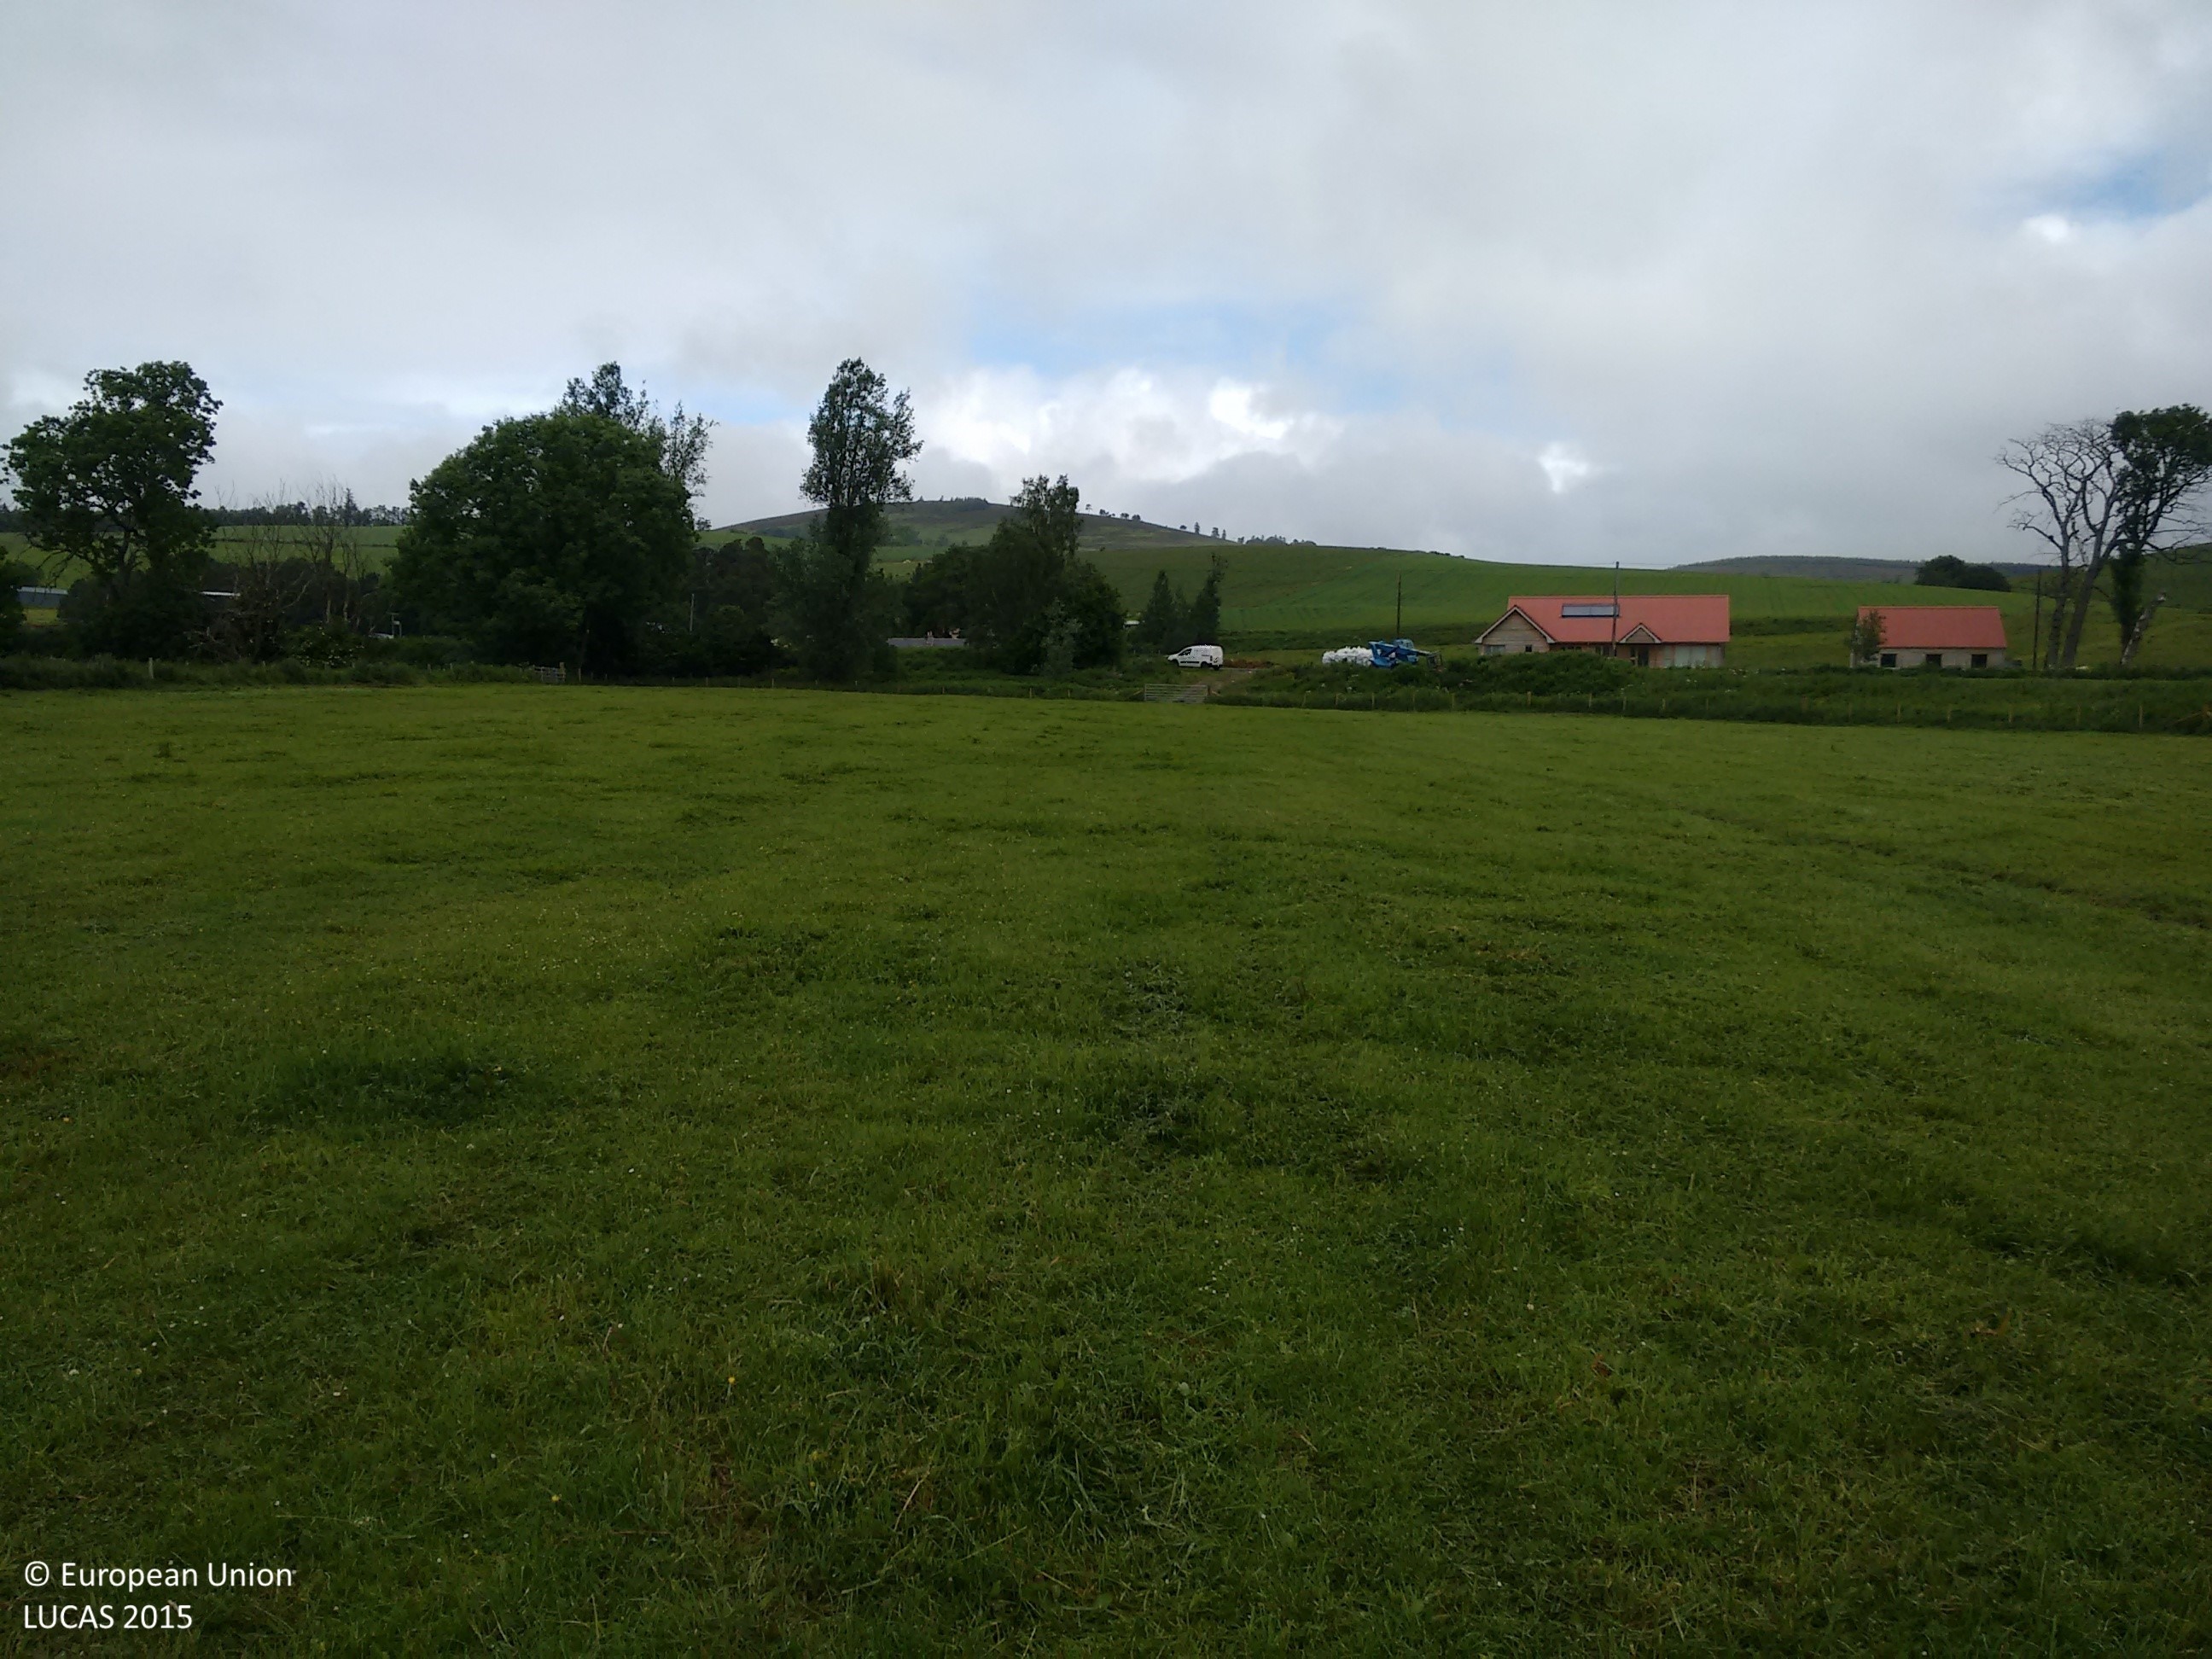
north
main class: Grassland
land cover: Grassland without tree/shrub cover
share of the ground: > 75 %
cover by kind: herbaceous plants 100 %
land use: Agriculture (excluding fallow land and kitchen gardens)
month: July
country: GB
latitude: 57.2087
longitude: -2.9249
